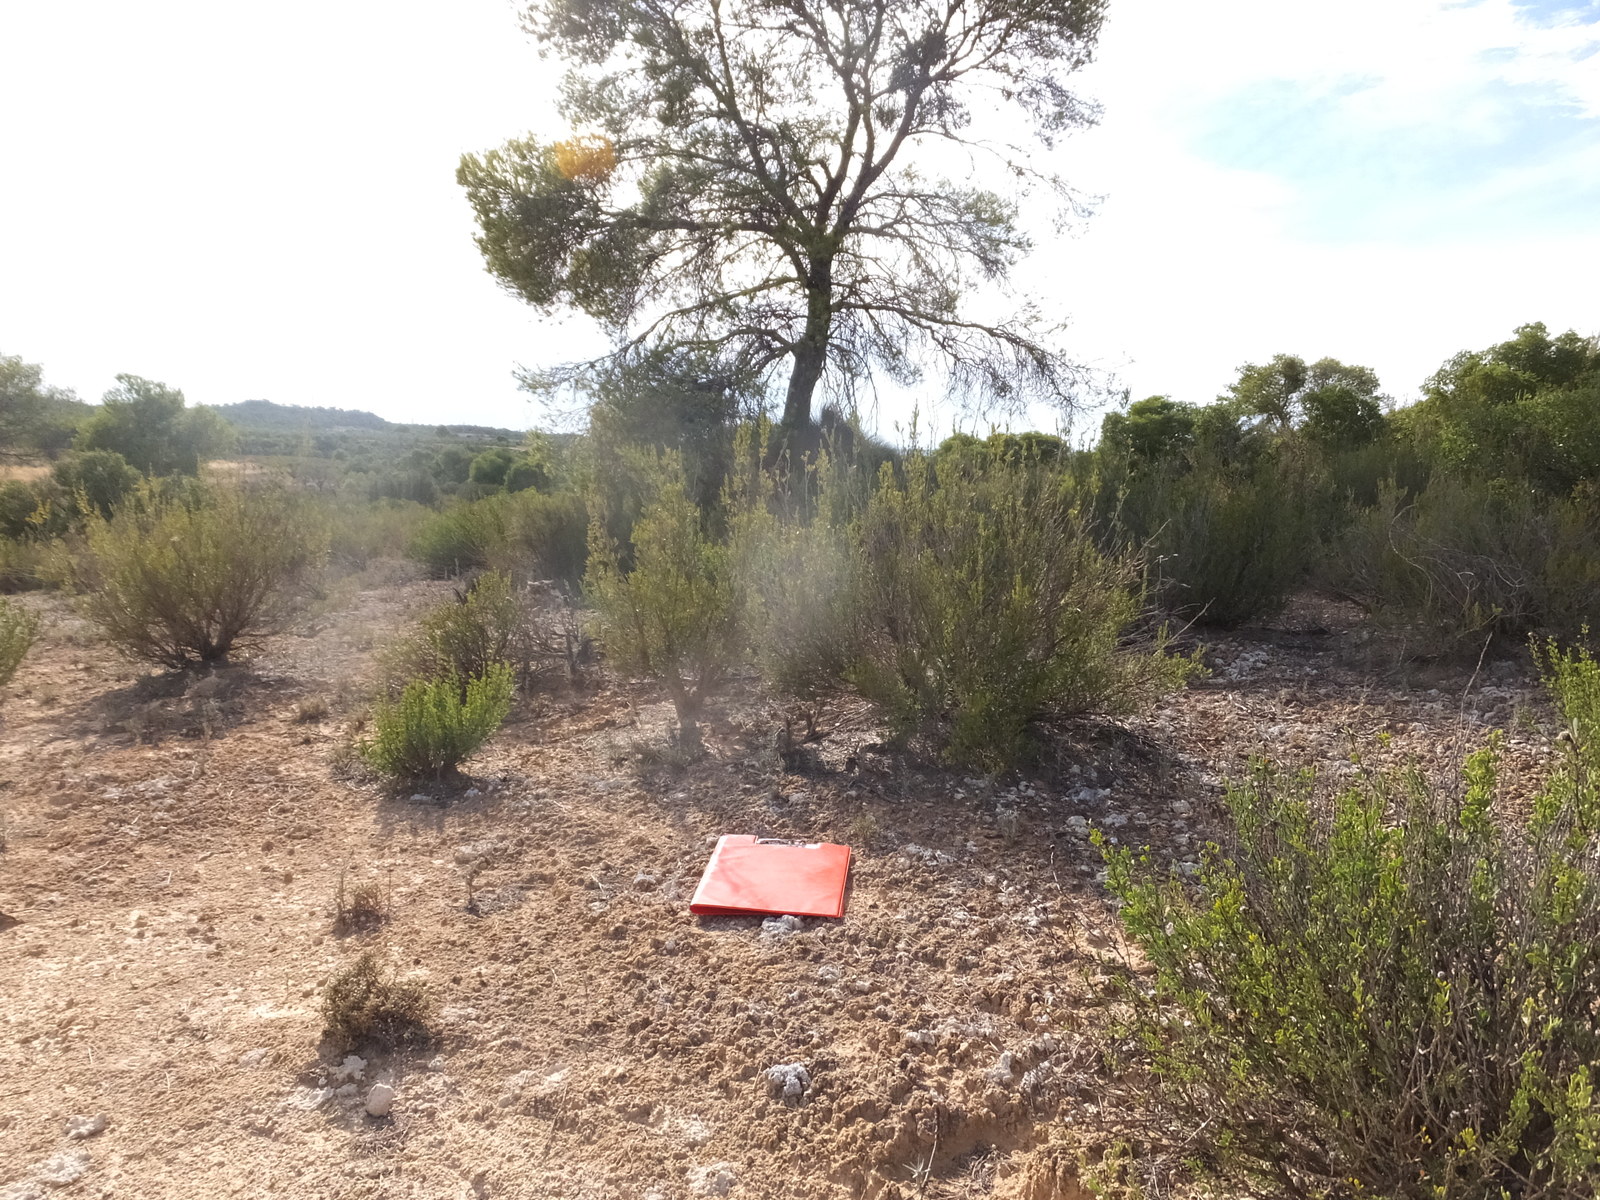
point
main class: Shrubland
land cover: Shrubland with sparse tree cover
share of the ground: > 75 %
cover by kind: shrubs 75 %, herbaceous plants 15 %, coniferous forest trees 5 %, unconsolidated bare surface 5 %
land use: Semi-natural and natural areas not in use
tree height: < 5 m
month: August
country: ES
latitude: 41.2781
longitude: 0.1146
